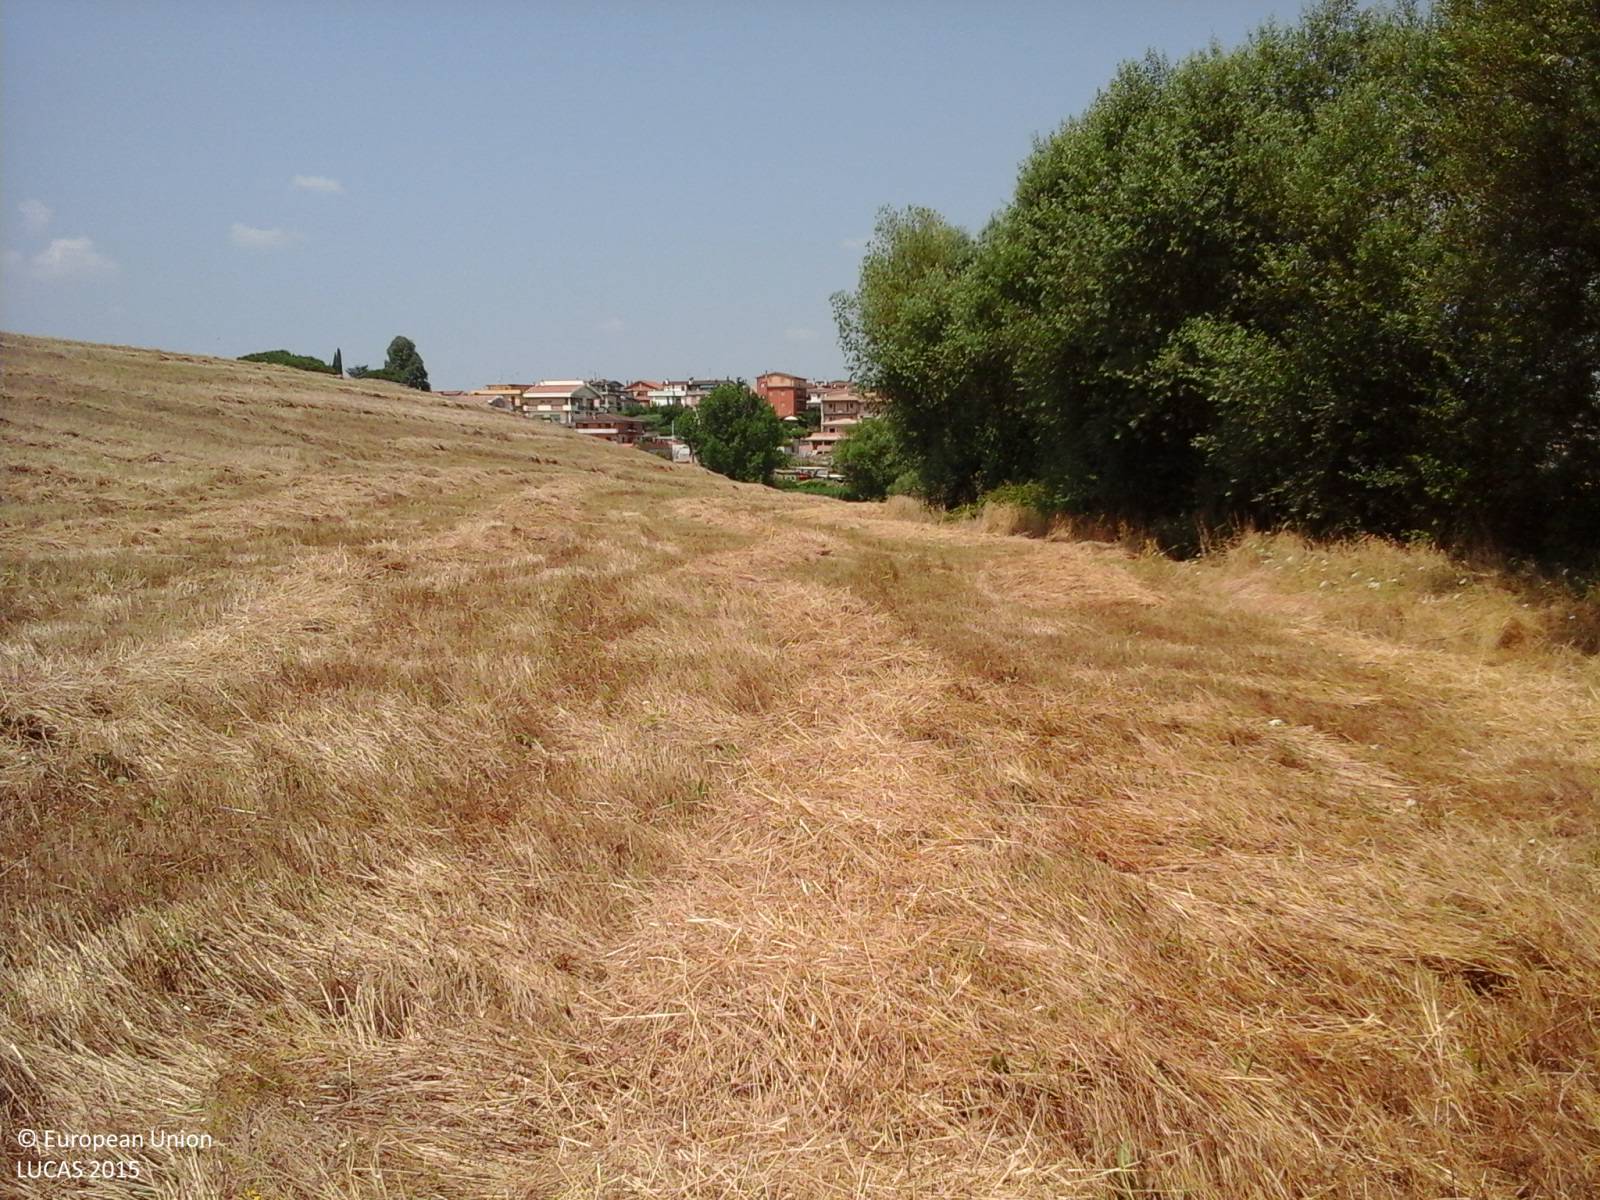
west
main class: Cropland
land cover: Temporary grasslands
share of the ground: > 75 %
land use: Agriculture (excluding fallow land and kitchen gardens)
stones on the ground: < 10 %
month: July
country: IT
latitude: 41.9710
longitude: 12.5609
